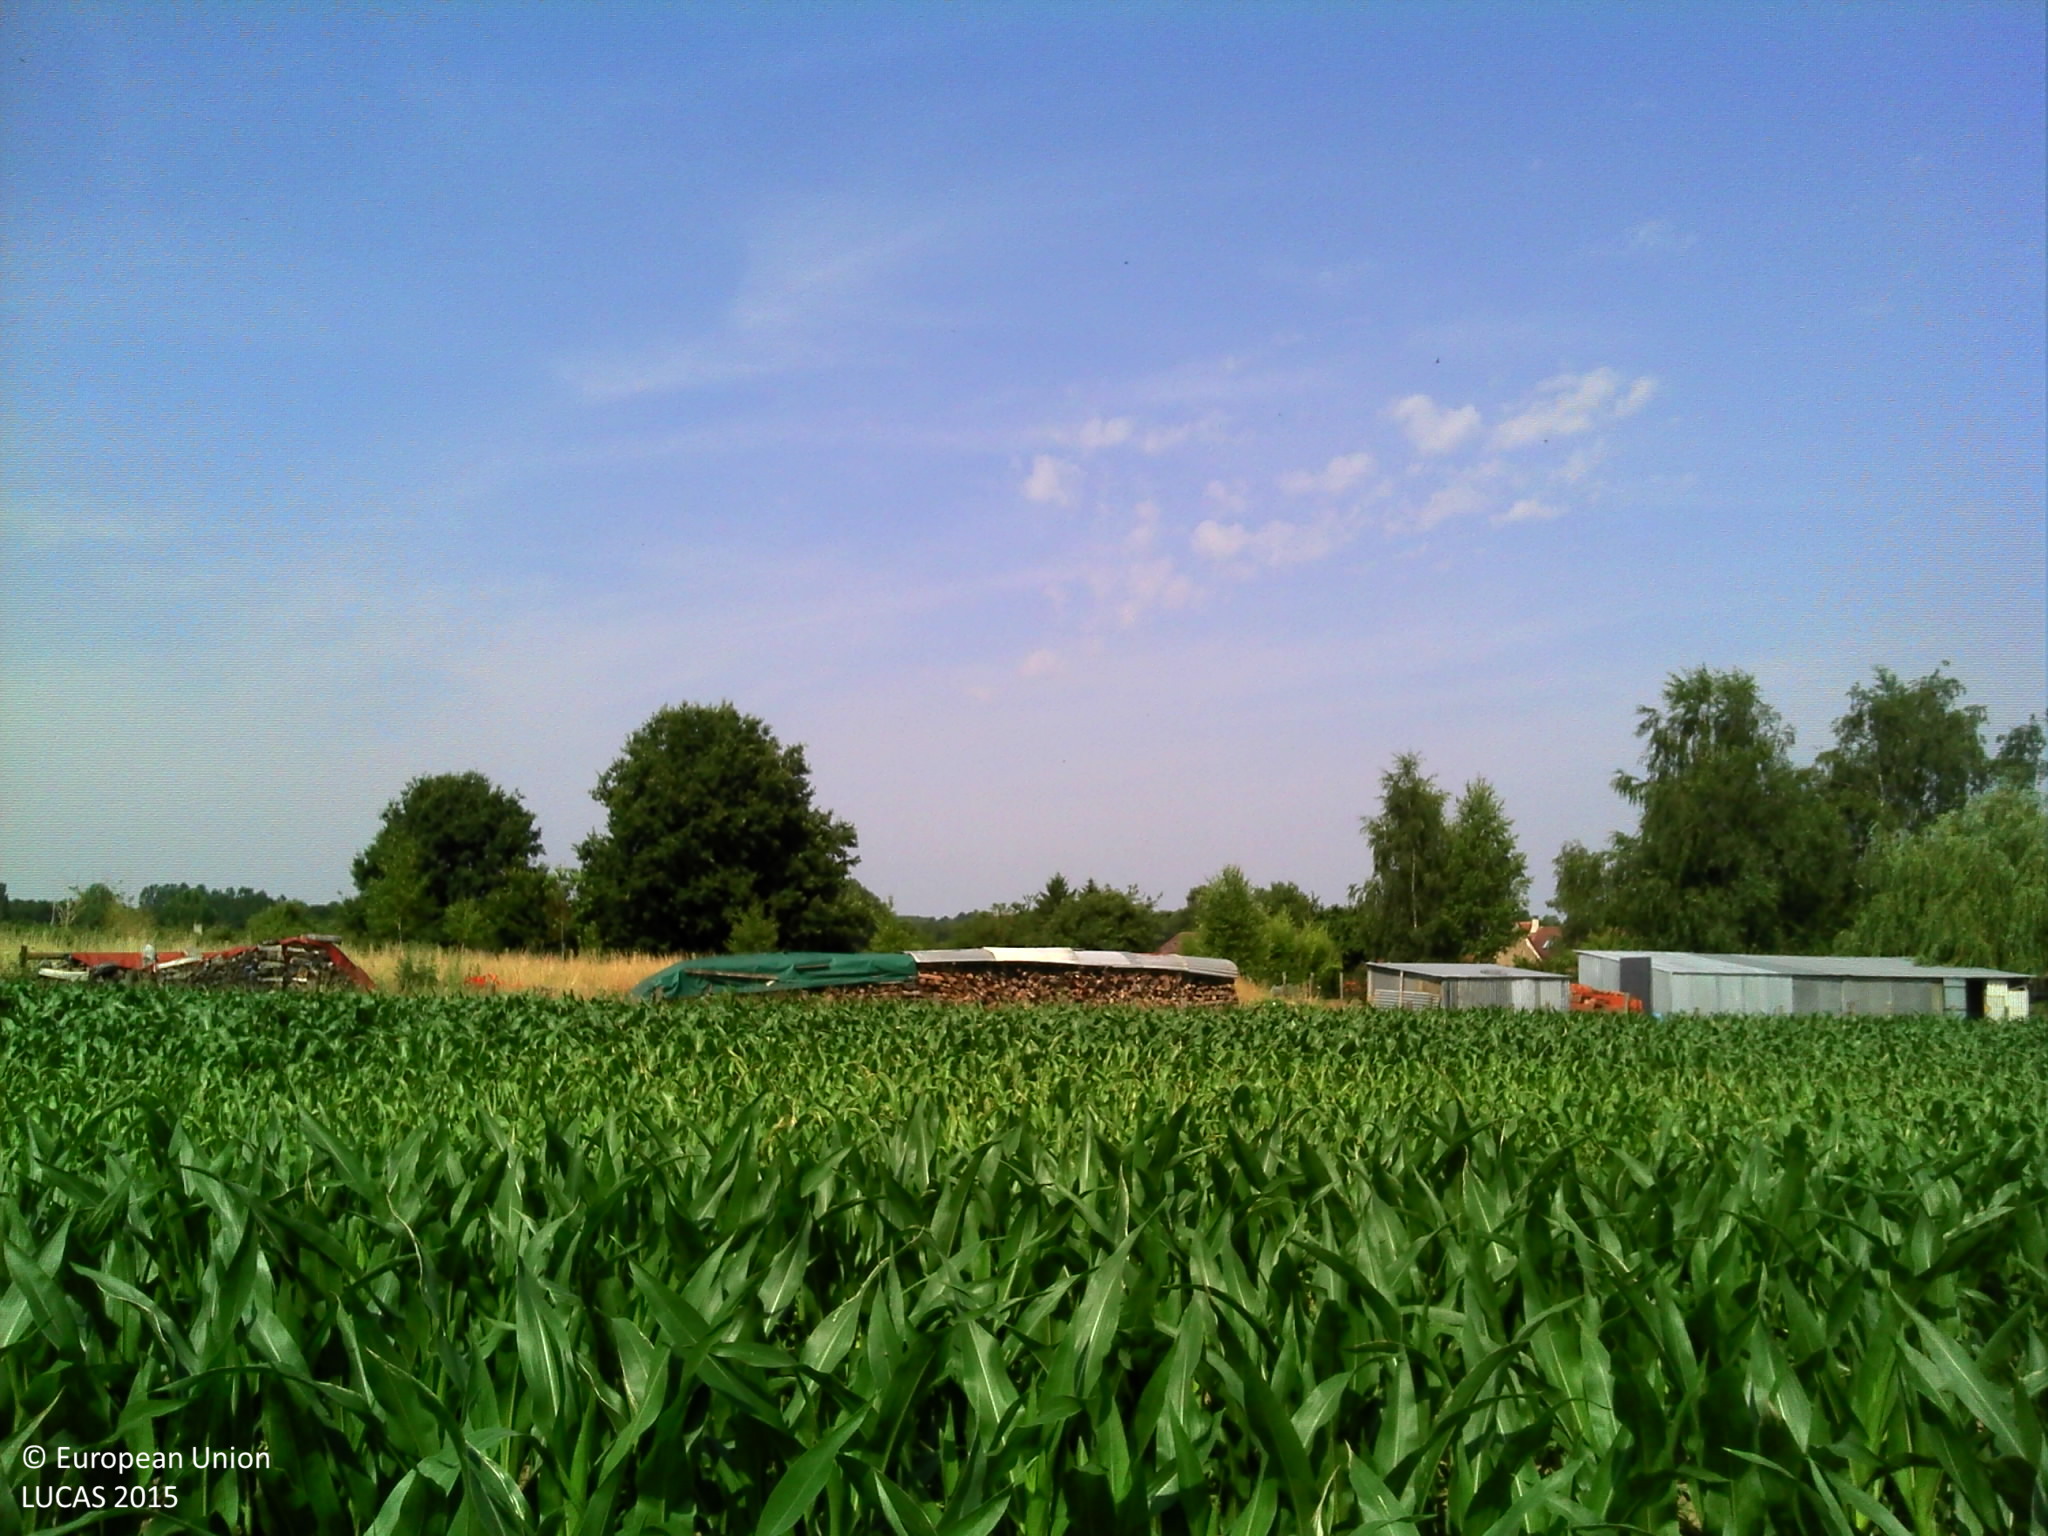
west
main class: Cropland
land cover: Maize
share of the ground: > 75 %
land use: Agriculture (excluding fallow land and kitchen gardens)
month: July
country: FR
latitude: 47.8231
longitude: 0.2107
